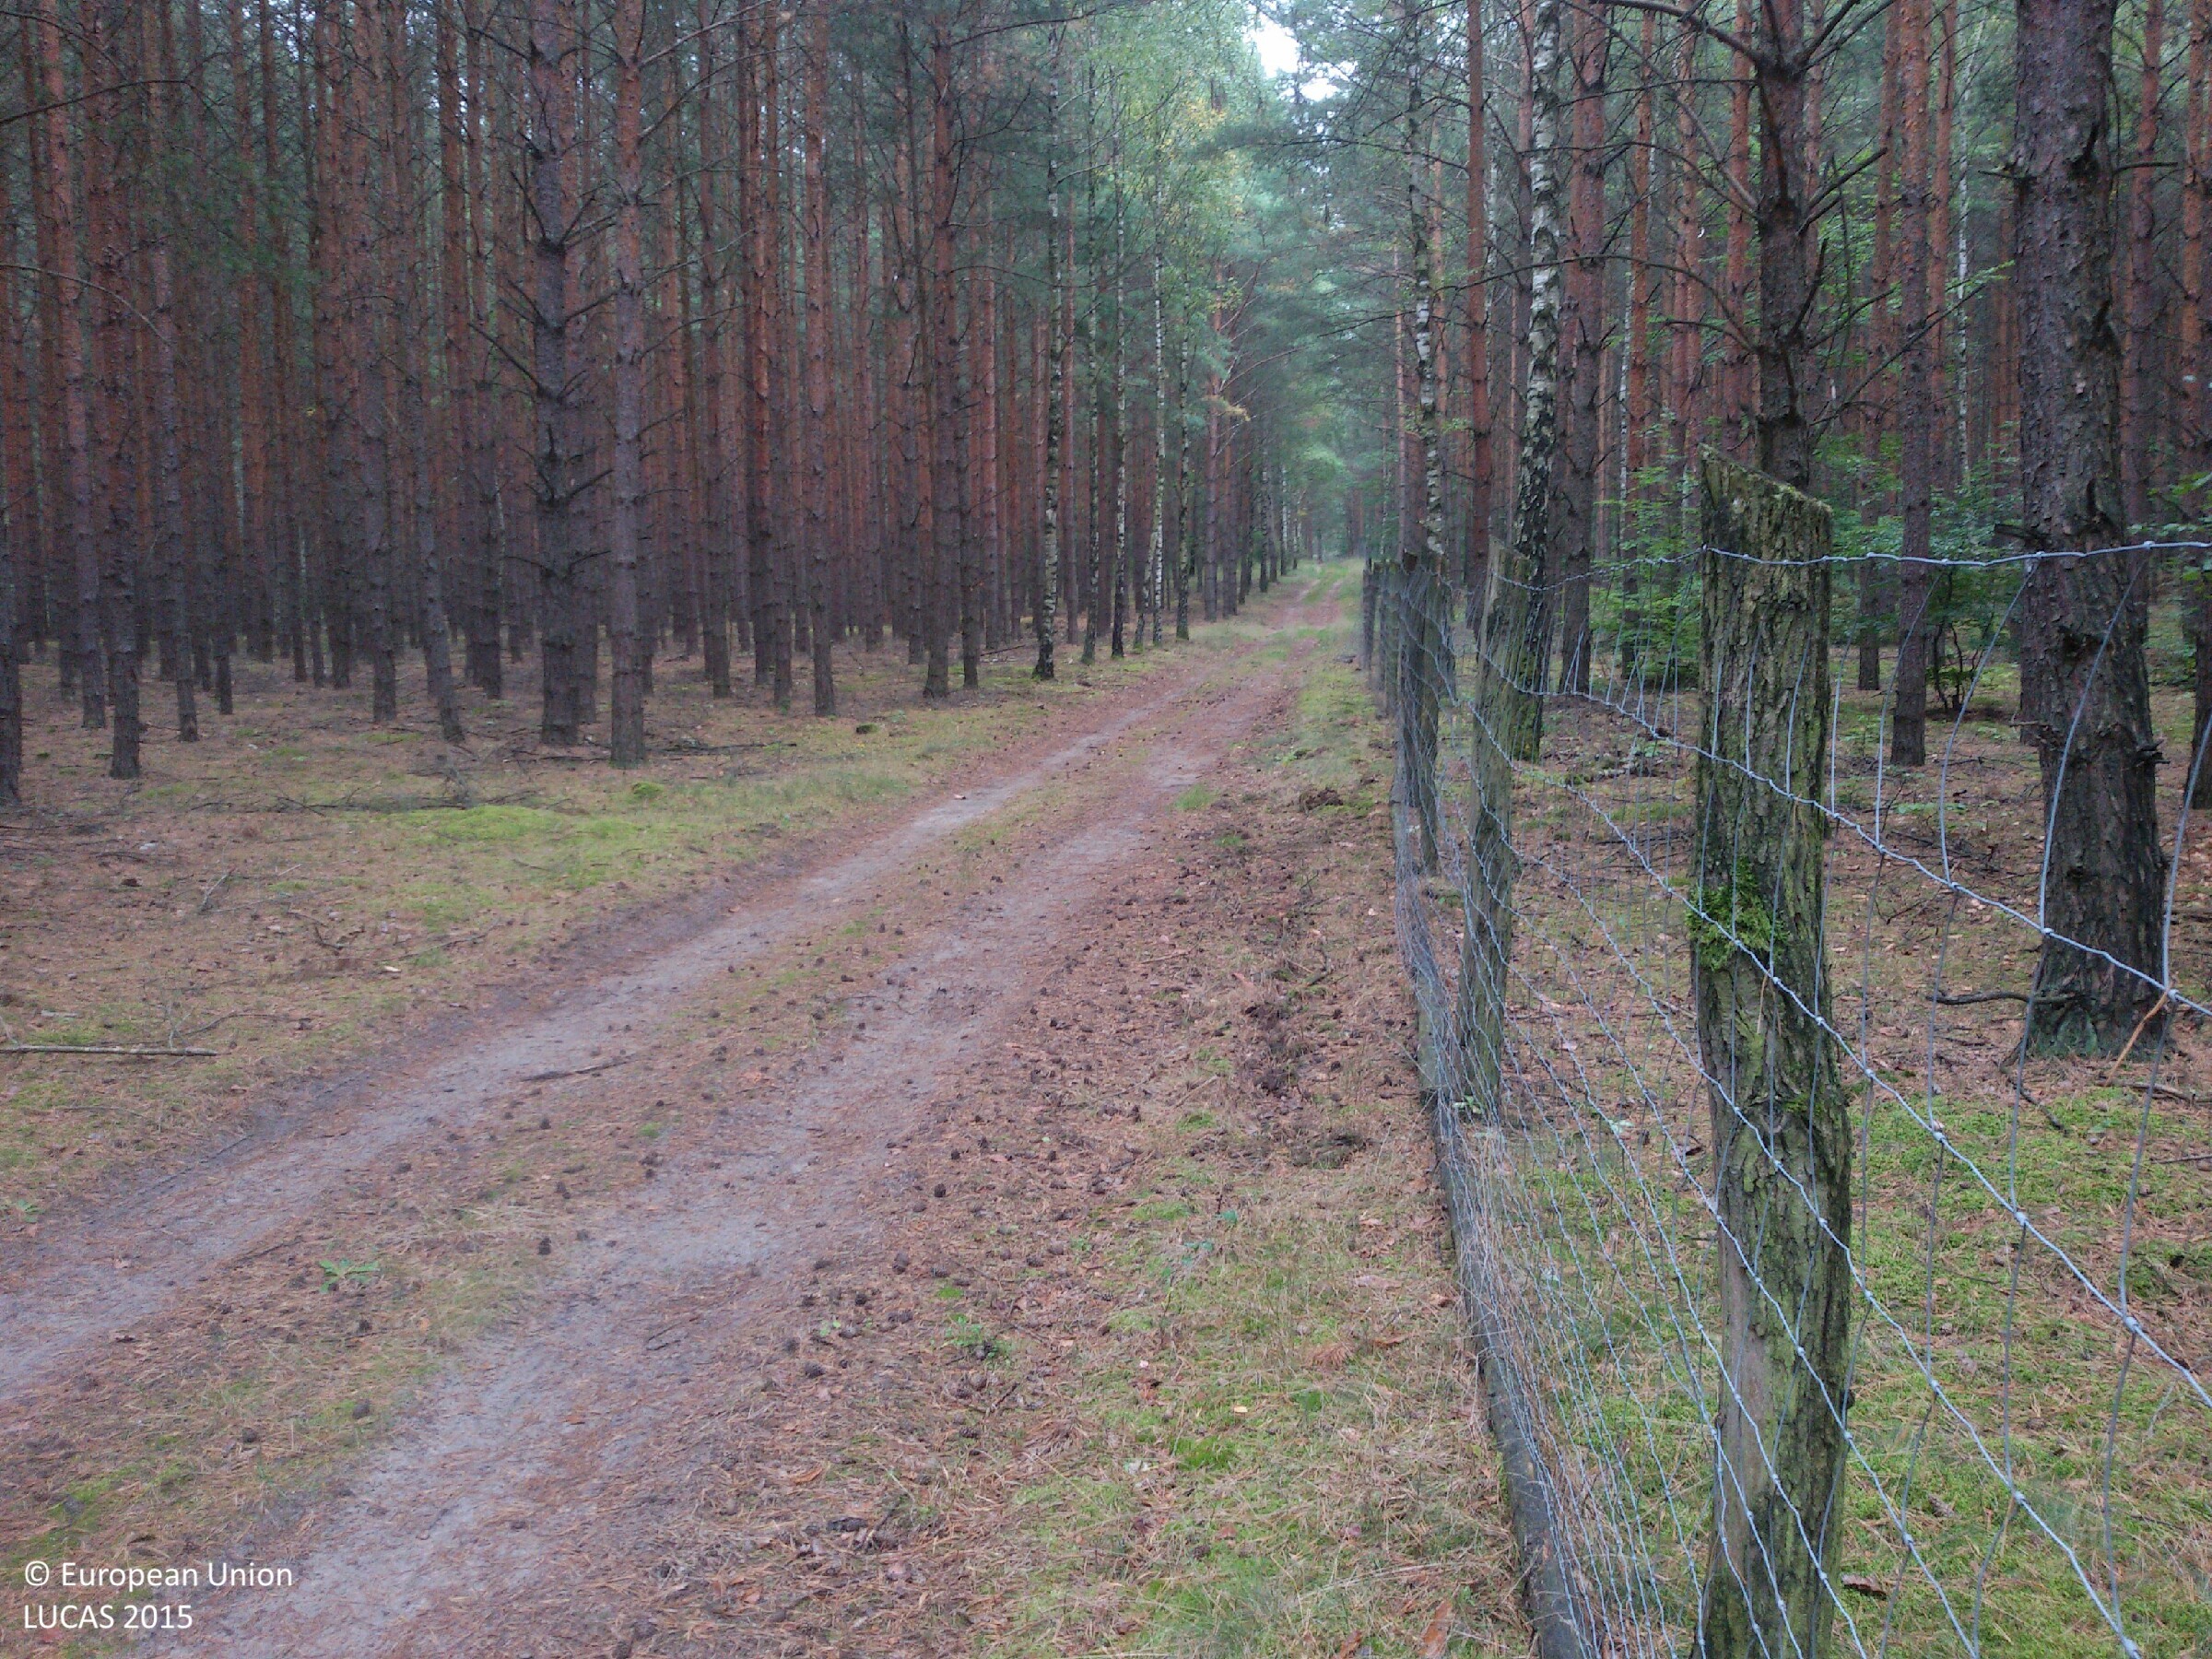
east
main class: Woodland
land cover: Pine dominated coniferous woodland
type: hemiboreal forest and nemoral coniferous forest and mixed broadleaved-coniferous forest
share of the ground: > 75 %
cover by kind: coniferous forest trees 85 %, lichens and mosses 10 %, broadleaved forest trees 5 %
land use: Forestry
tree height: > 5 m
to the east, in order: Pine dominated coniferous woodland; Fences; Tracks; Pine dominated mixed woodland; Pine dominated coniferous woodland
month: September
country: PL
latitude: 51.7271
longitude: 14.6784
